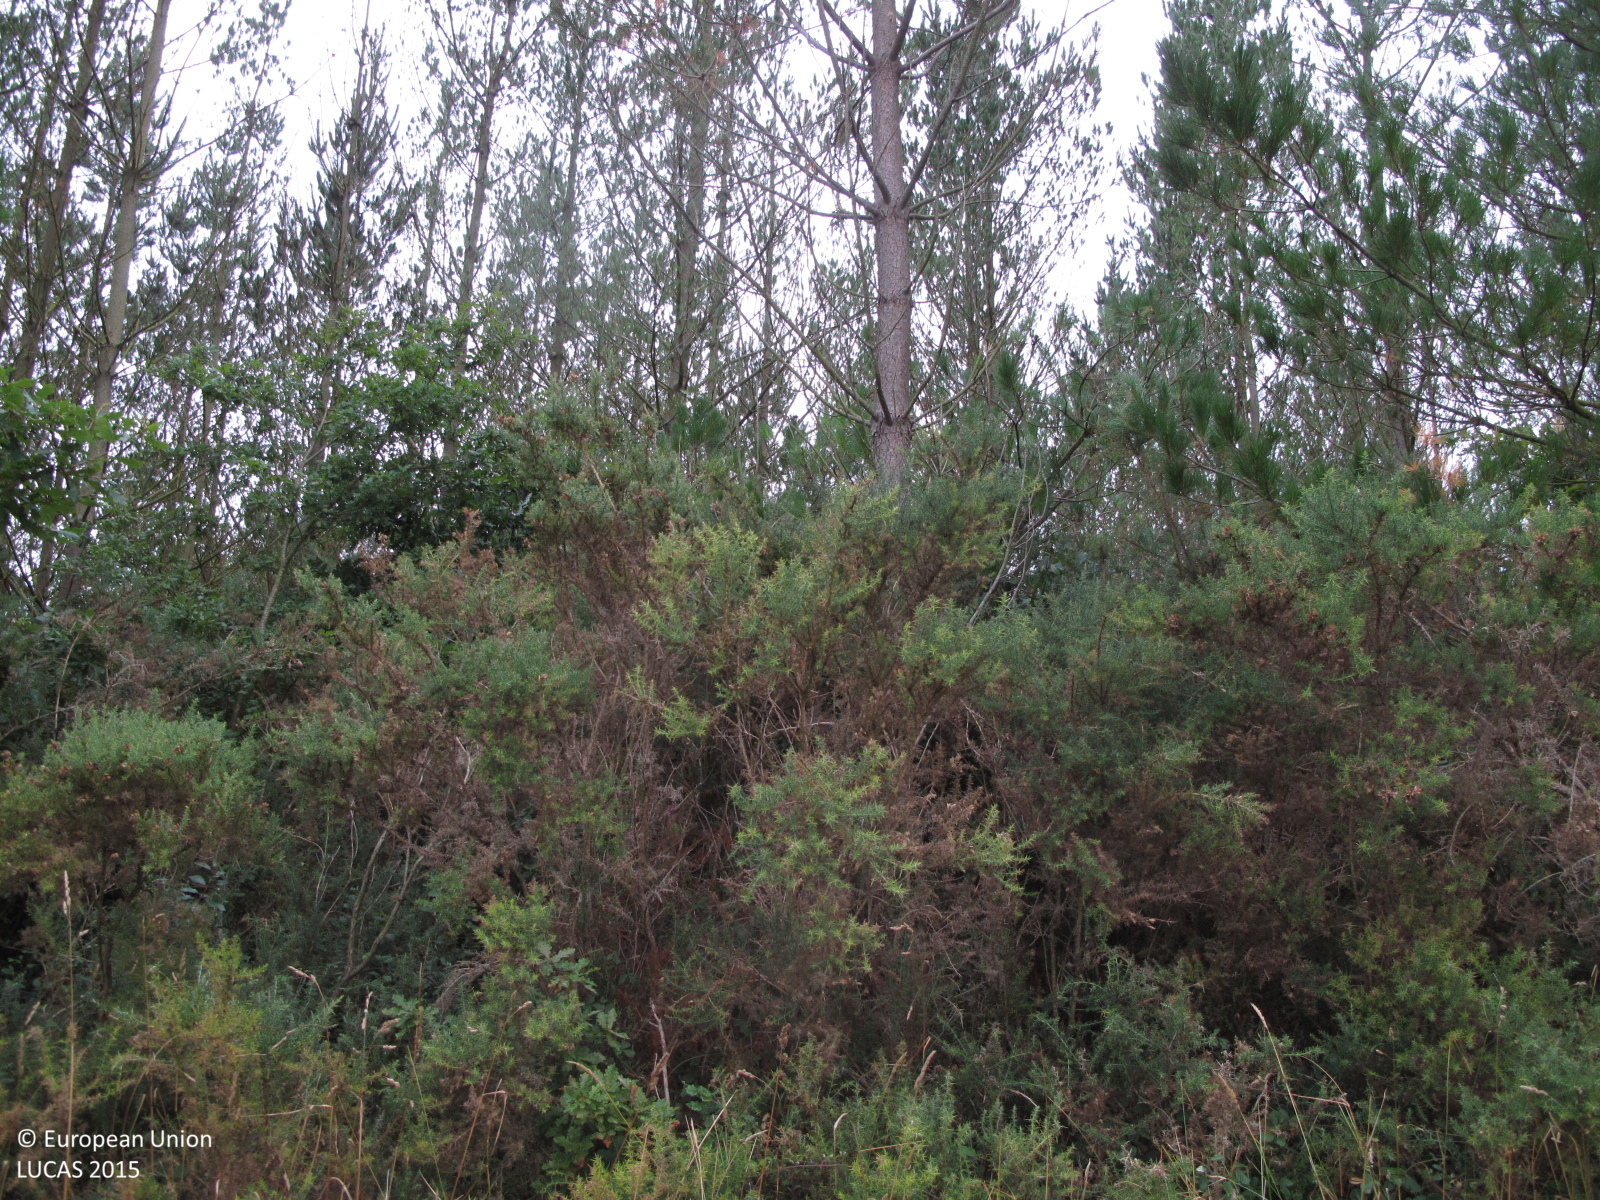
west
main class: Woodland
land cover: Pine dominated coniferous woodland
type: hemiboreal forest and nemoral coniferous forest and mixed broadleaved-coniferous forest
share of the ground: 50 - 75 %
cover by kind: coniferous forest trees 60 %, shrubs 40 %
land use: Forestry
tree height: > 5 m
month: July
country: ES
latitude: 43.2076
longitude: -7.9756
